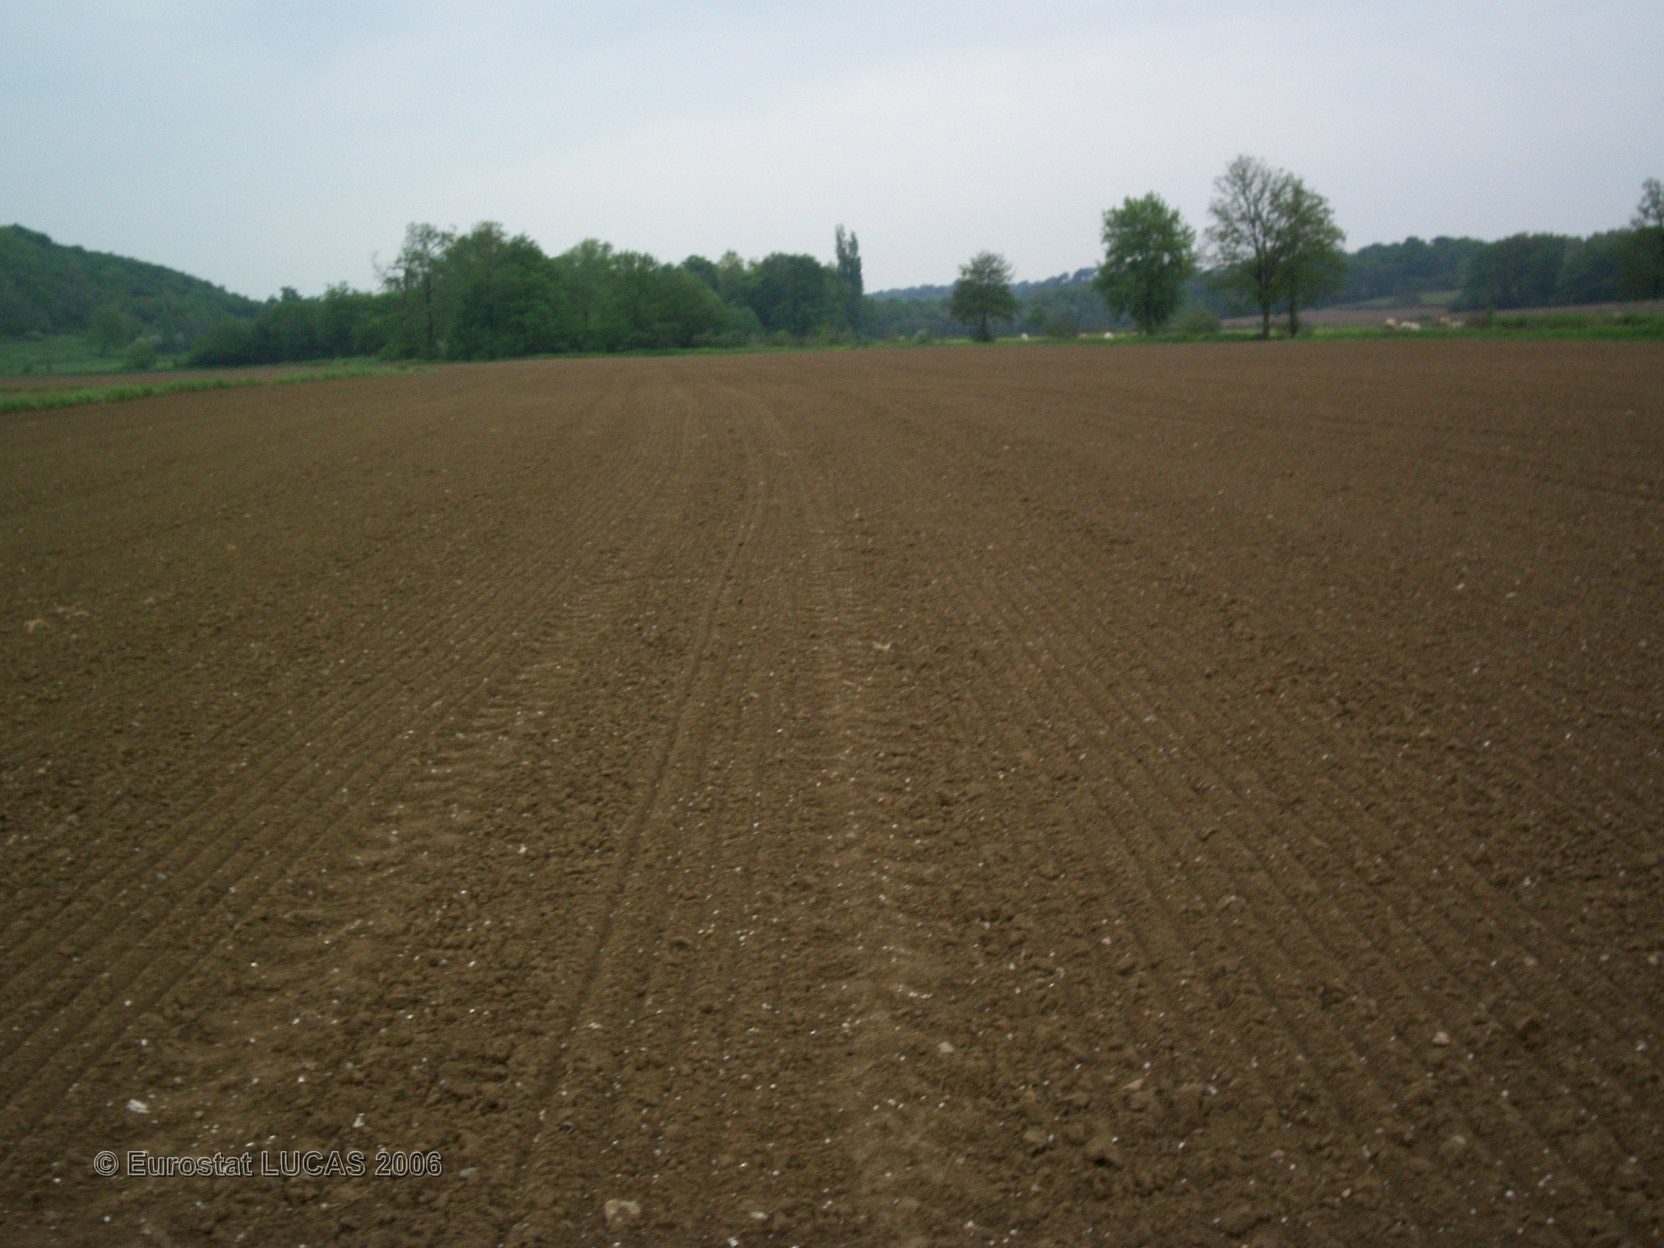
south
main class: Cropland
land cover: Maize
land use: Agriculture (excluding fallow land and kitchen gardens)
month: June
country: FR
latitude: 43.6845
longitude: -0.3678
